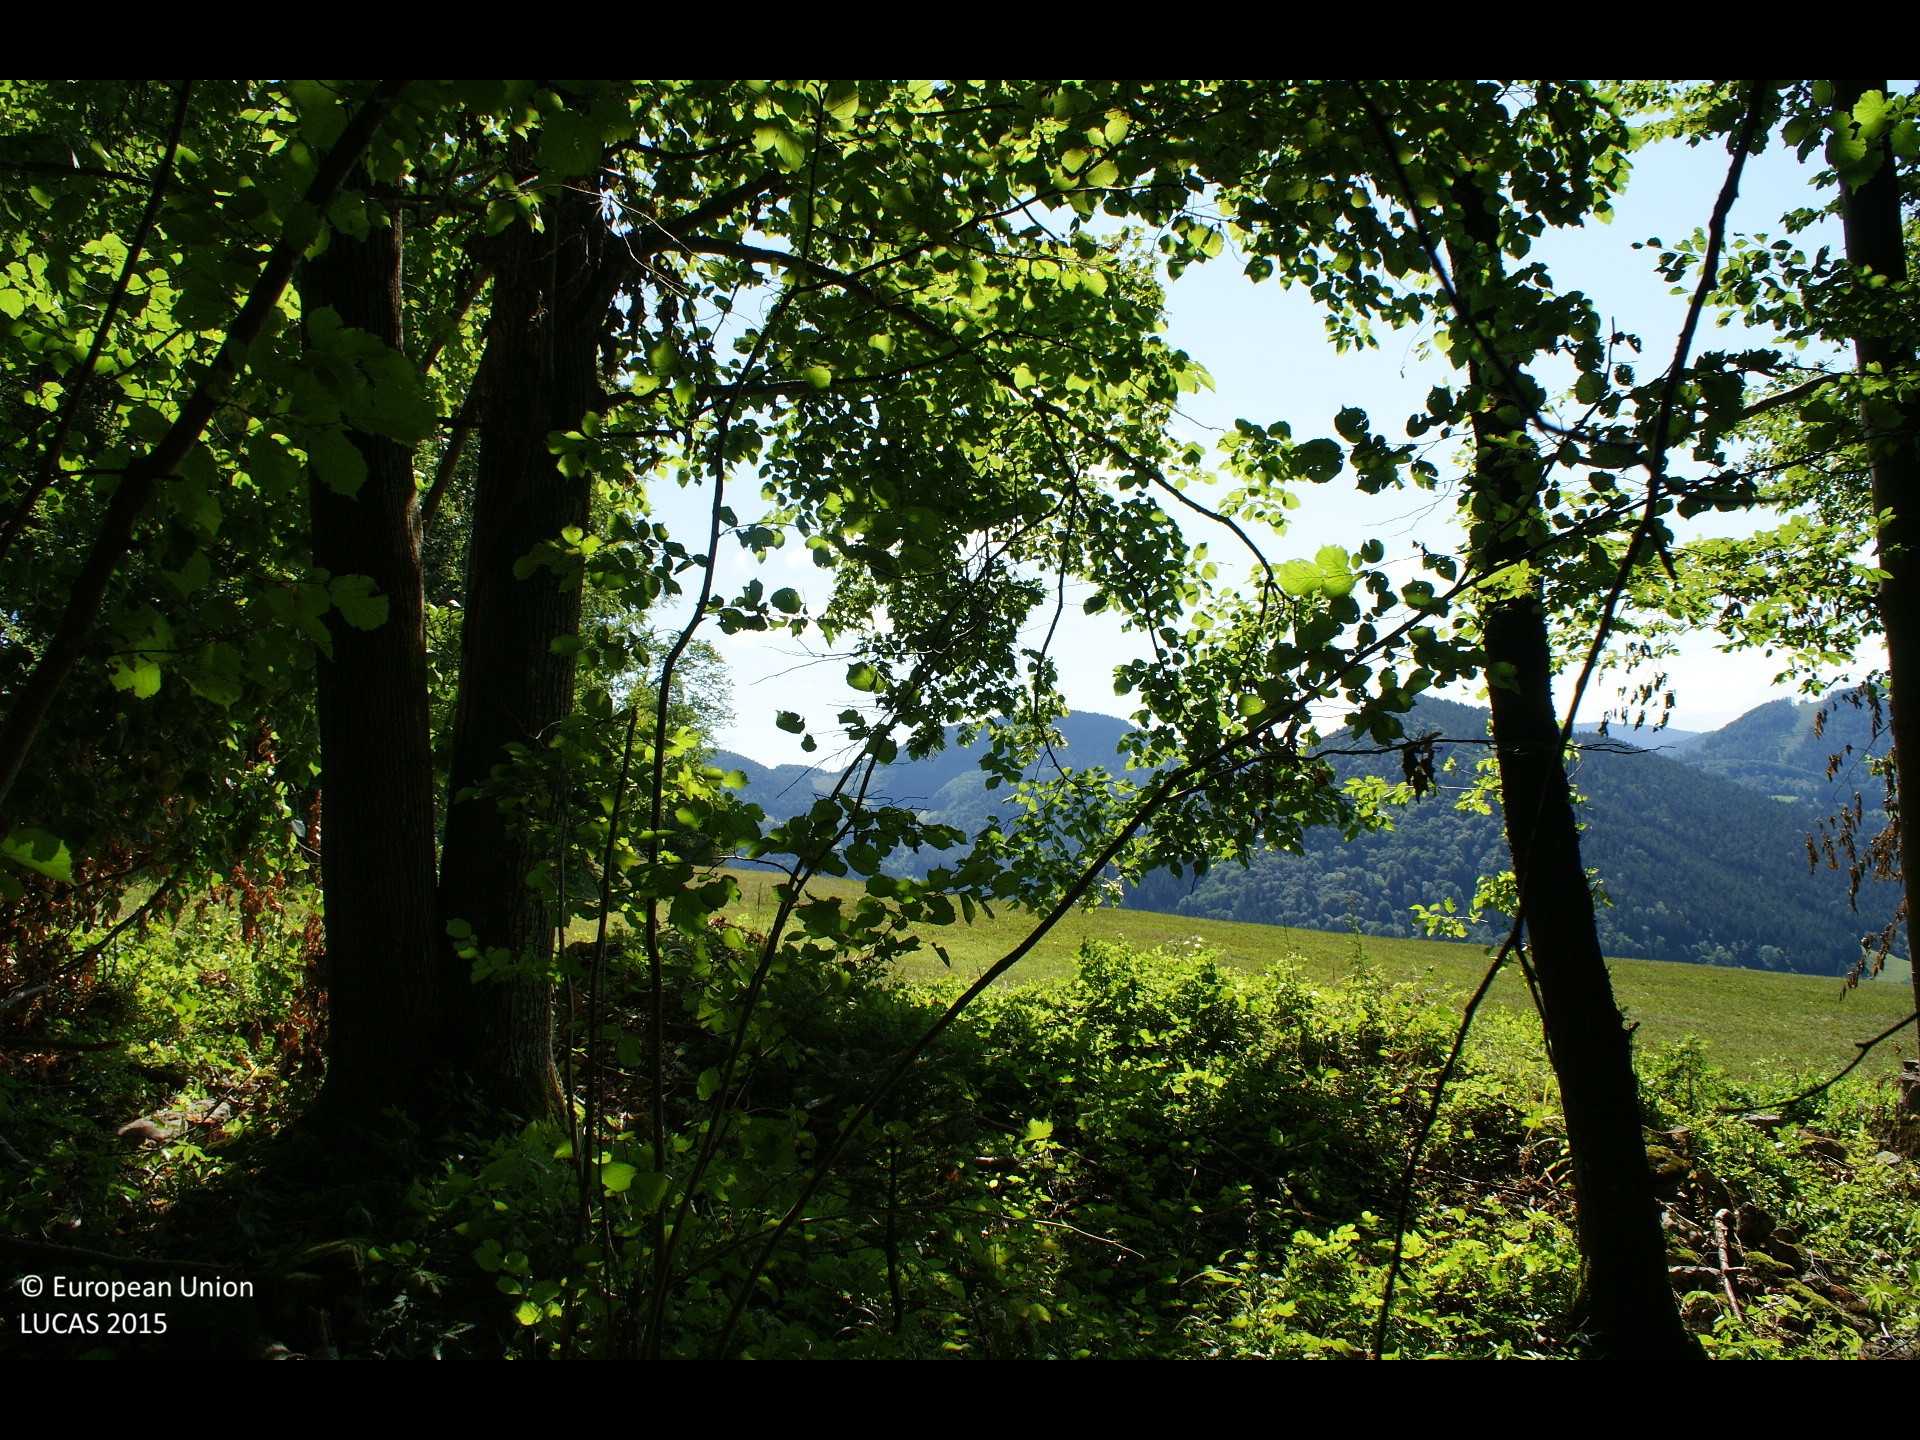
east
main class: Woodland
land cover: Broadleaved woodland
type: mountainous beech forest
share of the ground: > 75 %
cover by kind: broadleaved forest trees 80 %, coniferous forest trees 10 %, herbaceous plants 10 %
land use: Forestry
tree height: > 5 m
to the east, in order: Broadleaved woodland; Grassland without tree/shrub cover; Broadleaved woodland; Grassland without tree/shrub cover; Other mixed woodland; Fences; Other mixed woodland
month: July
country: AT
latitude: 47.9702
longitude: 15.2924
